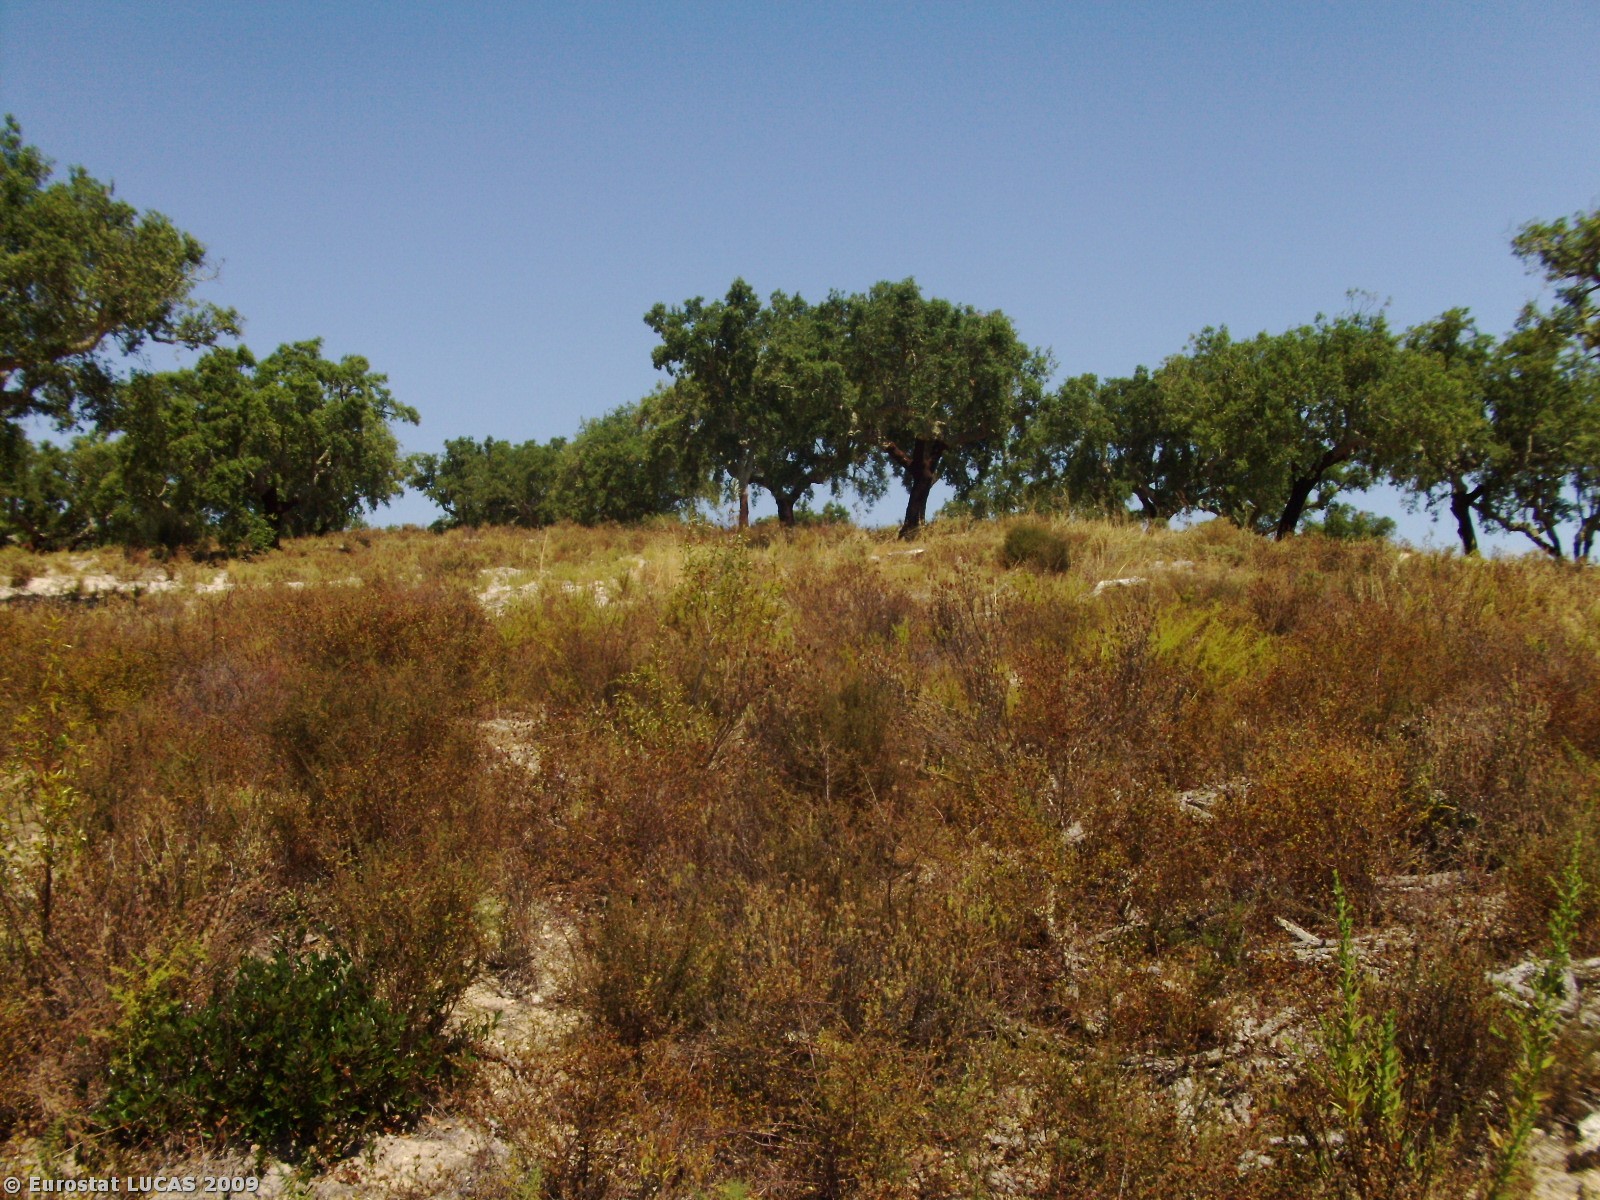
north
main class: Woodland
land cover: Broadleaved woodland
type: broadleaved evergreen forest
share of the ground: 10 - 25 %
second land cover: Spontaneously vegetated surfaces
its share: 50 - 75 %
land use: Forestry
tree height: > 5 m
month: August
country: PT
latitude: 39.2212
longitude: -8.0671
